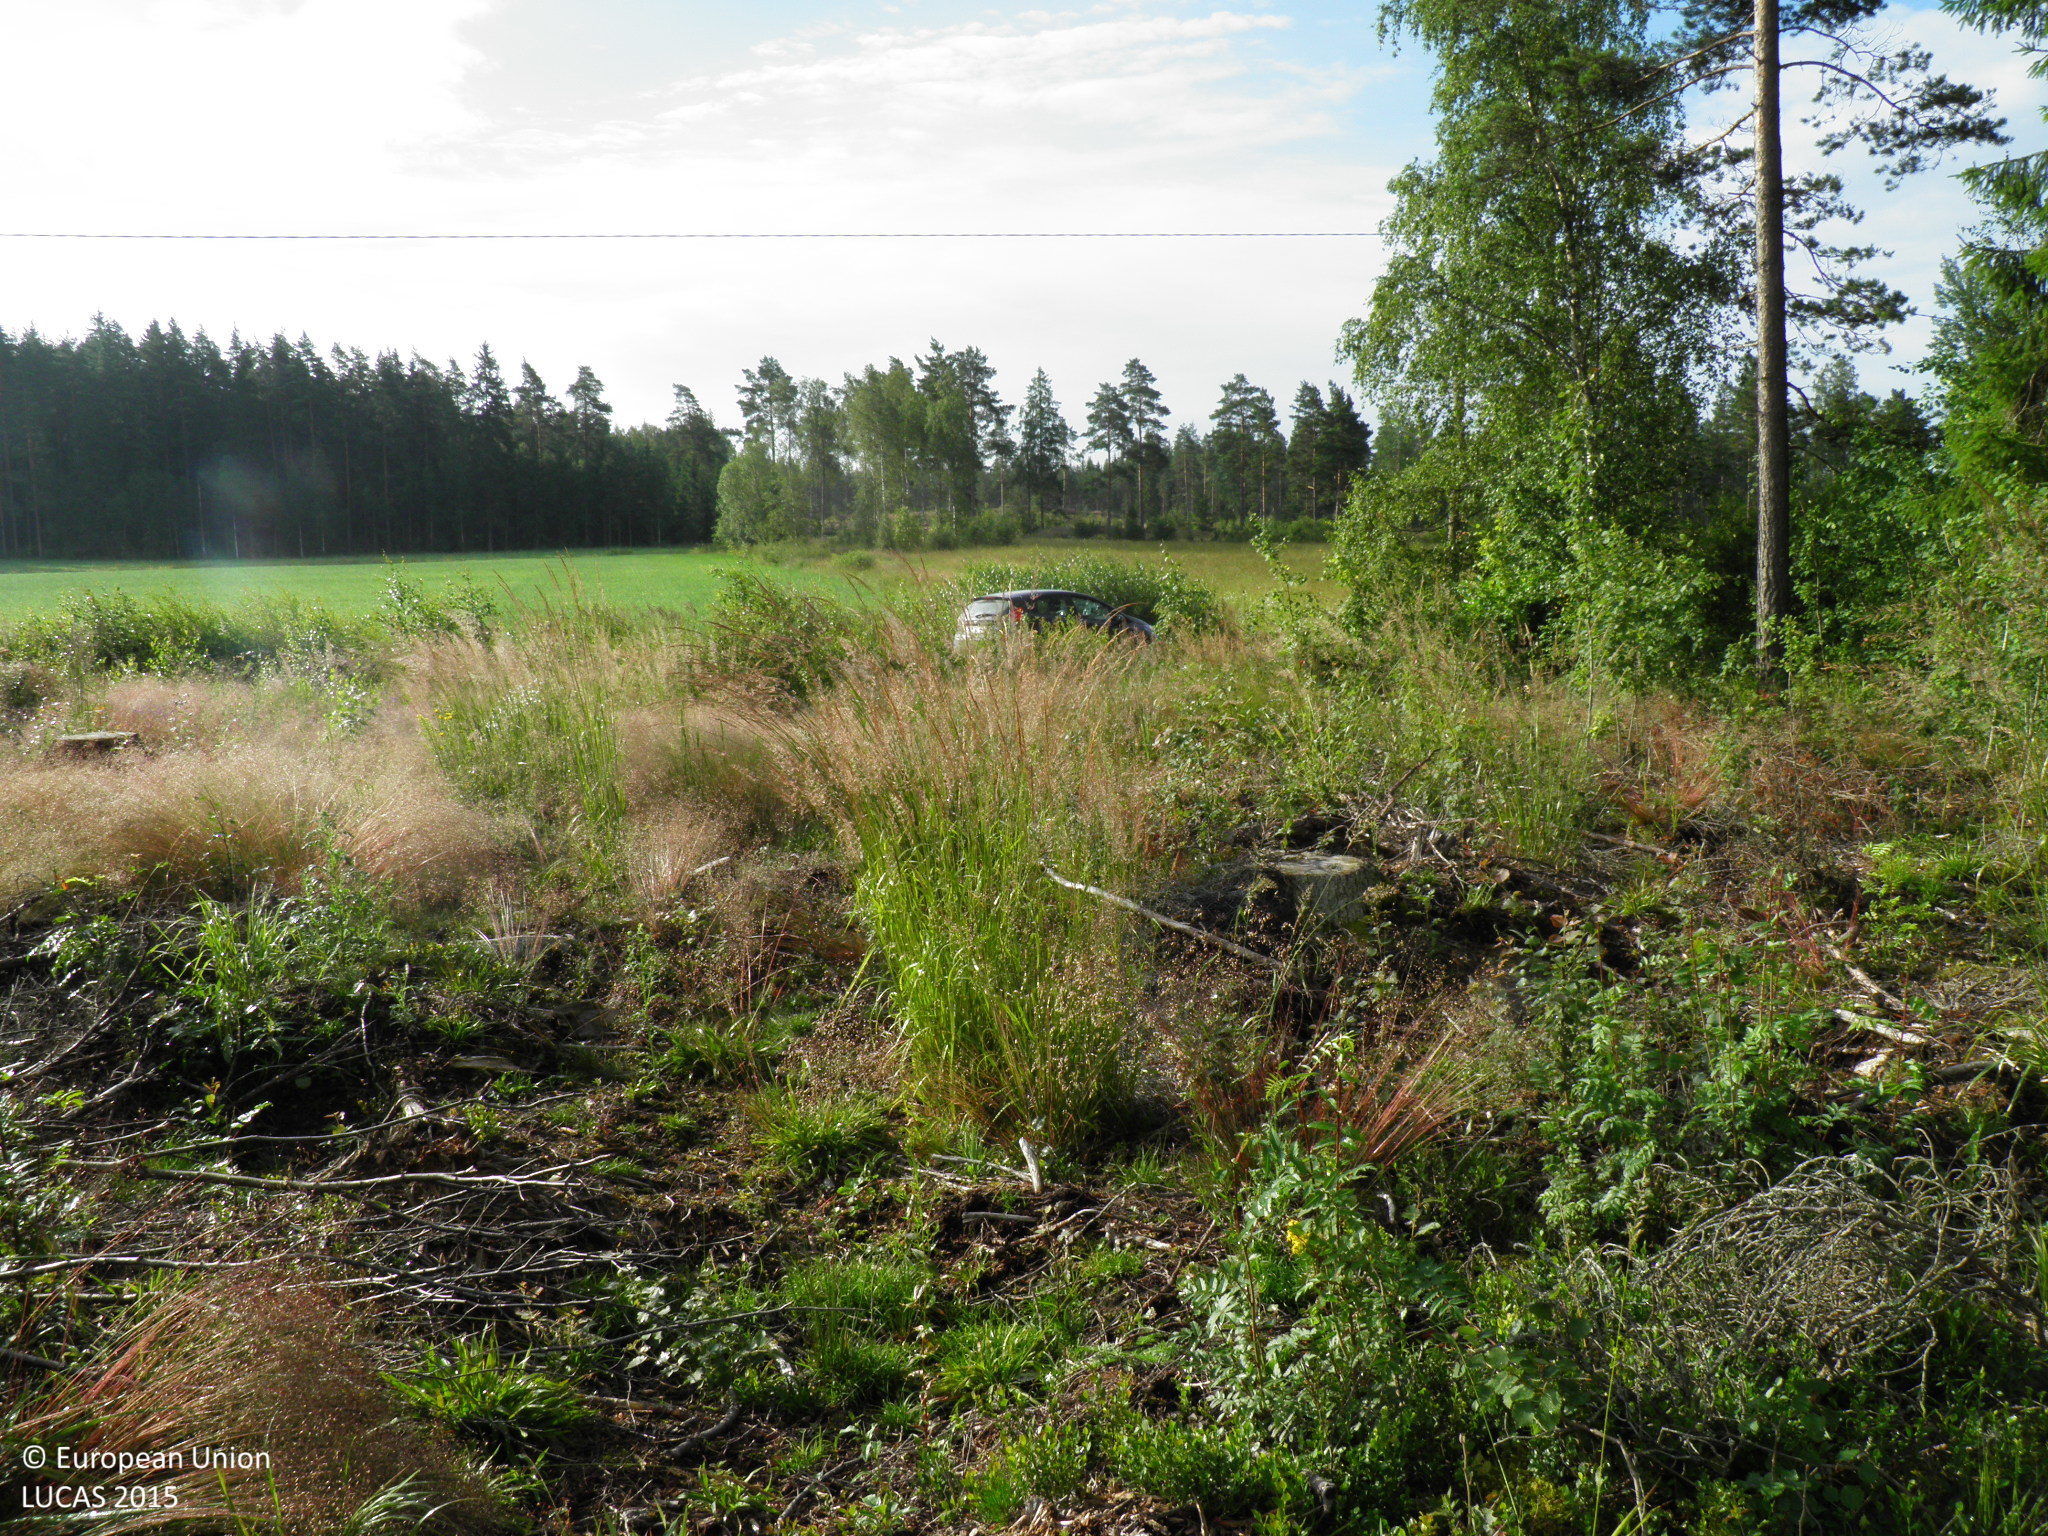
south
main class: Grassland
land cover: Grassland with sparse tree/shrub cover
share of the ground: 50 - 75 %
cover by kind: herbaceous plants 40 %, unconsolidated bare surface 35 %, shrubs 10 %, lichens and mosses 10 %, coniferous forest trees 5 %
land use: Forestry
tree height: < 5 m
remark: Clear cut
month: July
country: FI
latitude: 60.1162
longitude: 22.6888
